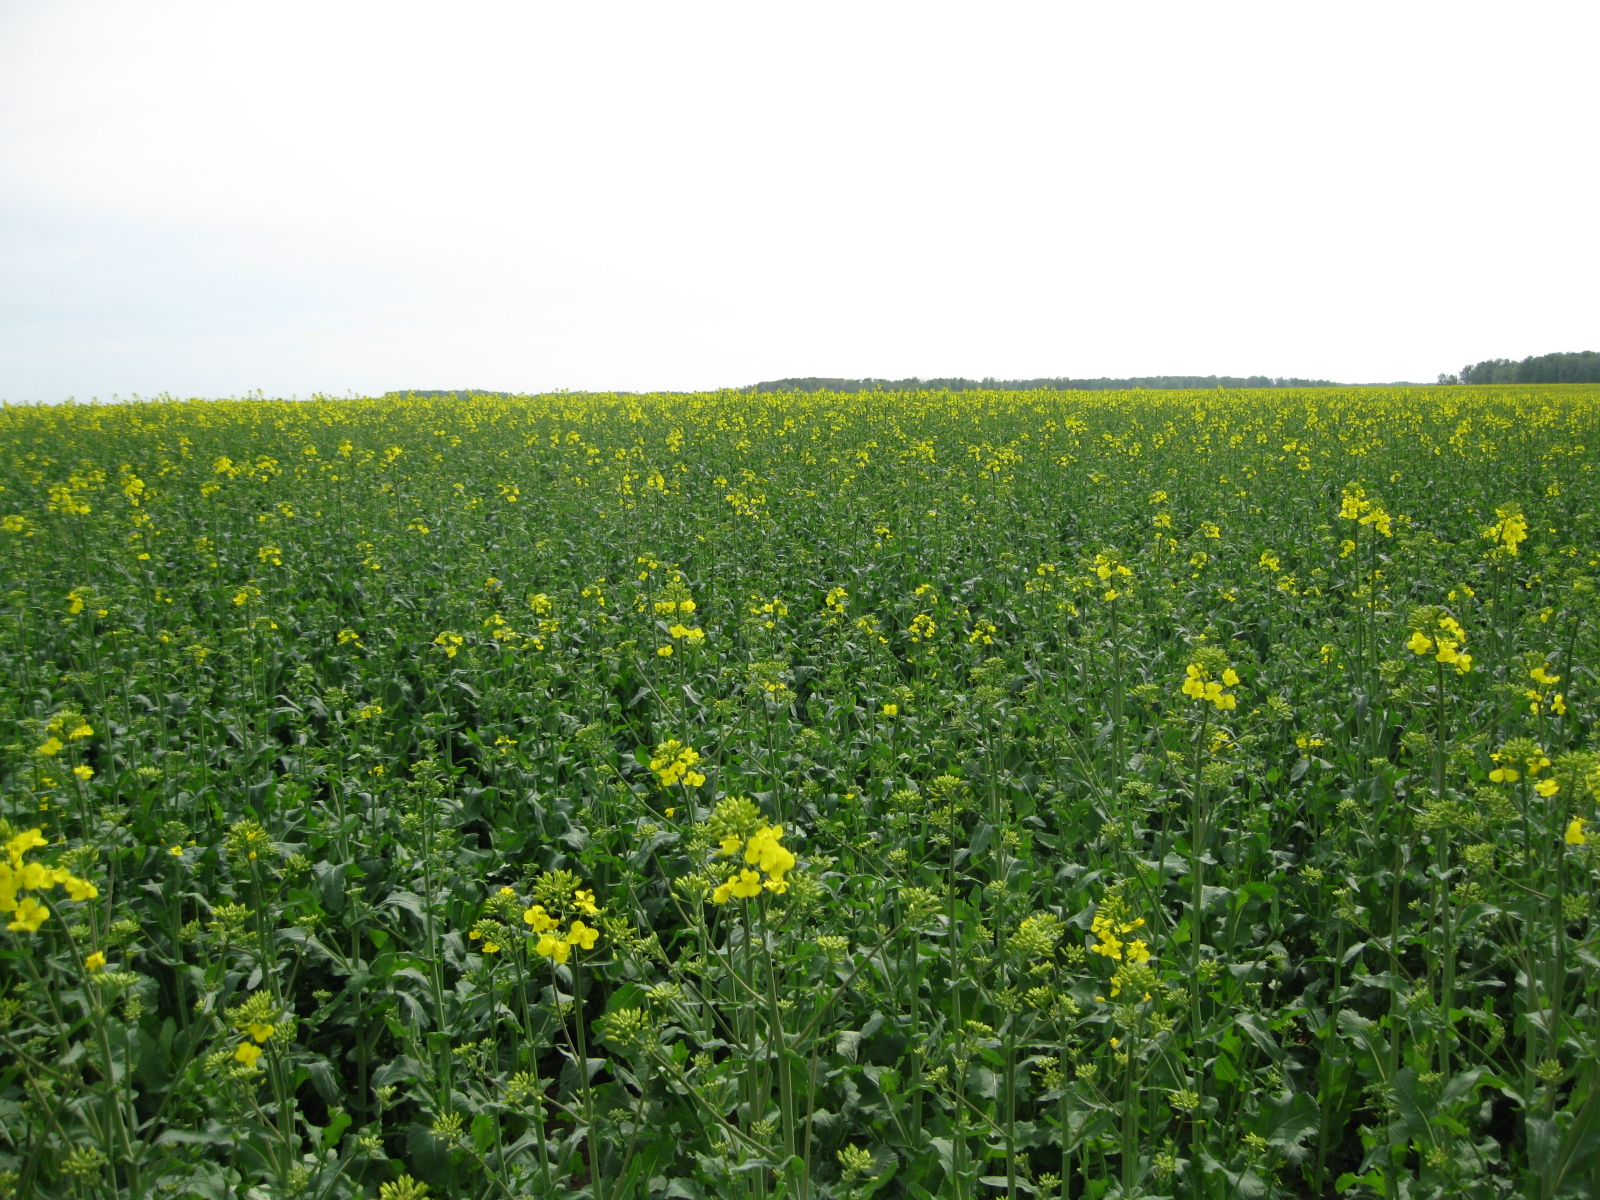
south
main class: Grassland
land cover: Spontaneously vegetated surfaces
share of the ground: > 75 %
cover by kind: herbaceous plants 100 %
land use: Fallow land
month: May
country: LT
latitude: 56.2963
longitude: 24.2959
